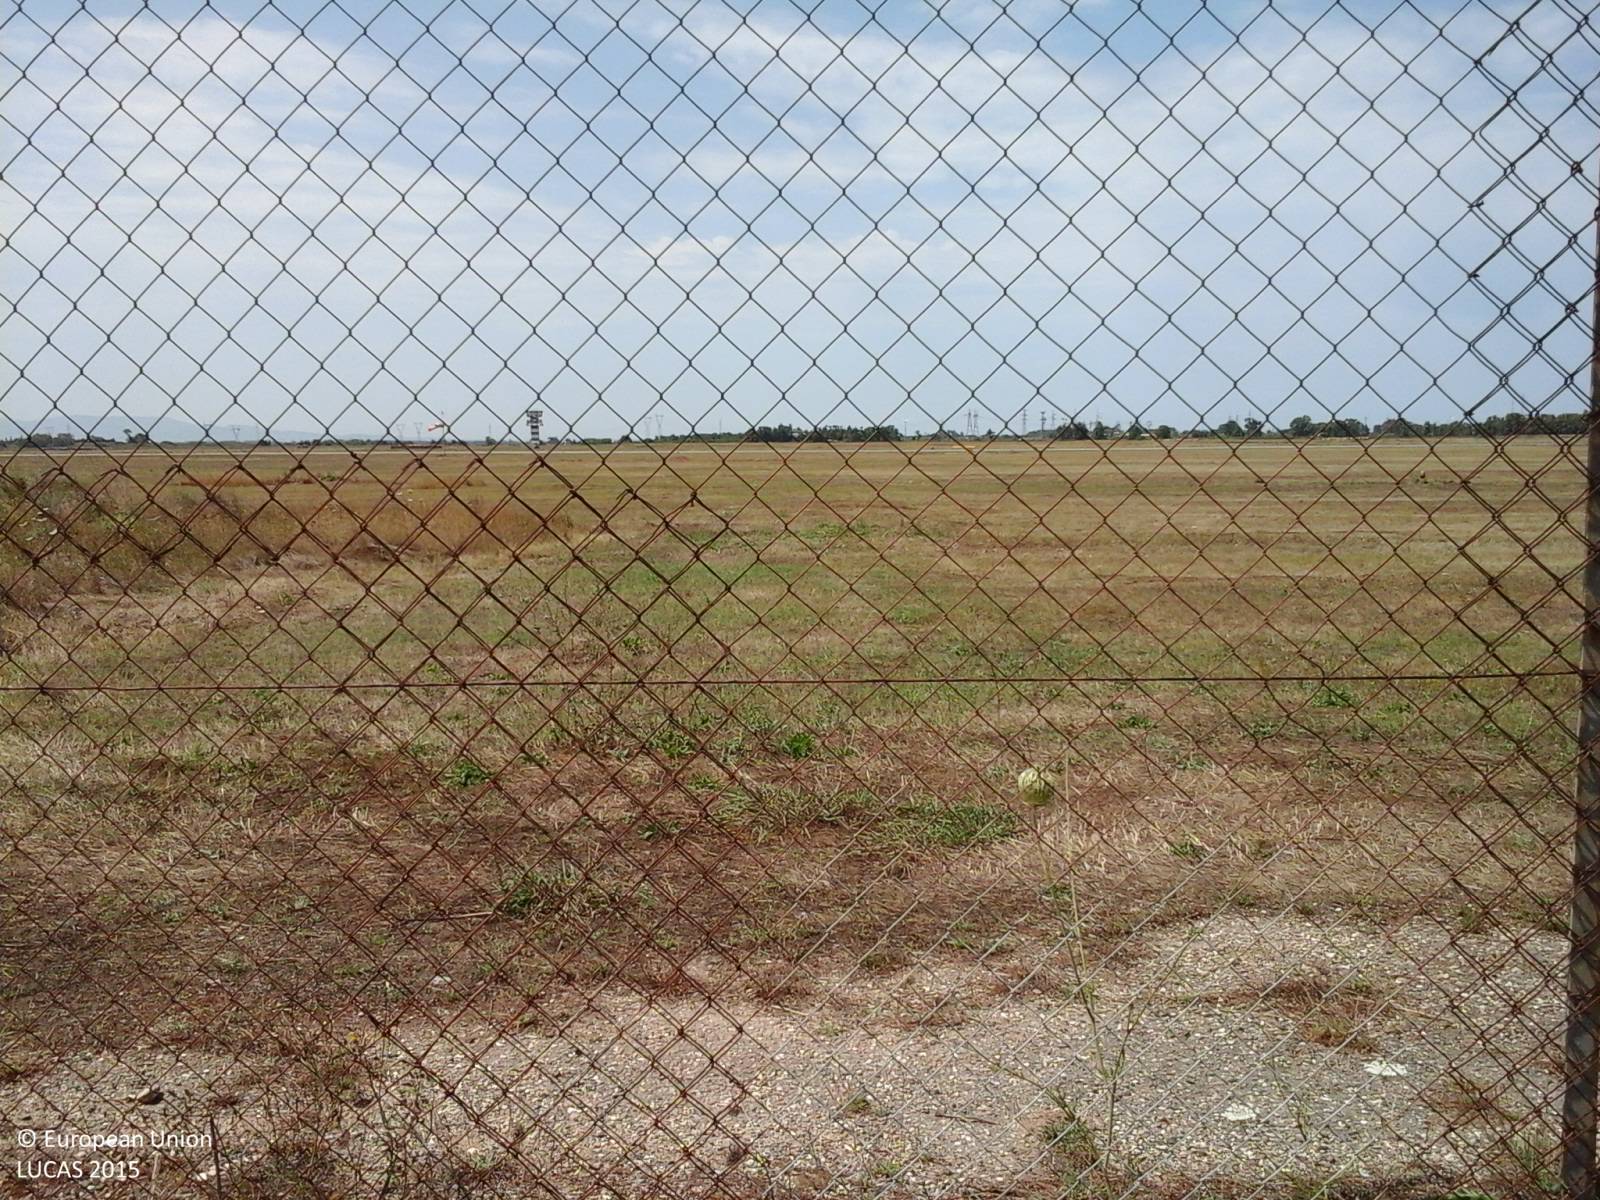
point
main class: Grassland
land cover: Grassland without tree/shrub cover
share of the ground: > 75 %
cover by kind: herbaceous plants 100 %
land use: Air transport
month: June
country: IT
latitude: 39.8957
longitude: 8.6392
